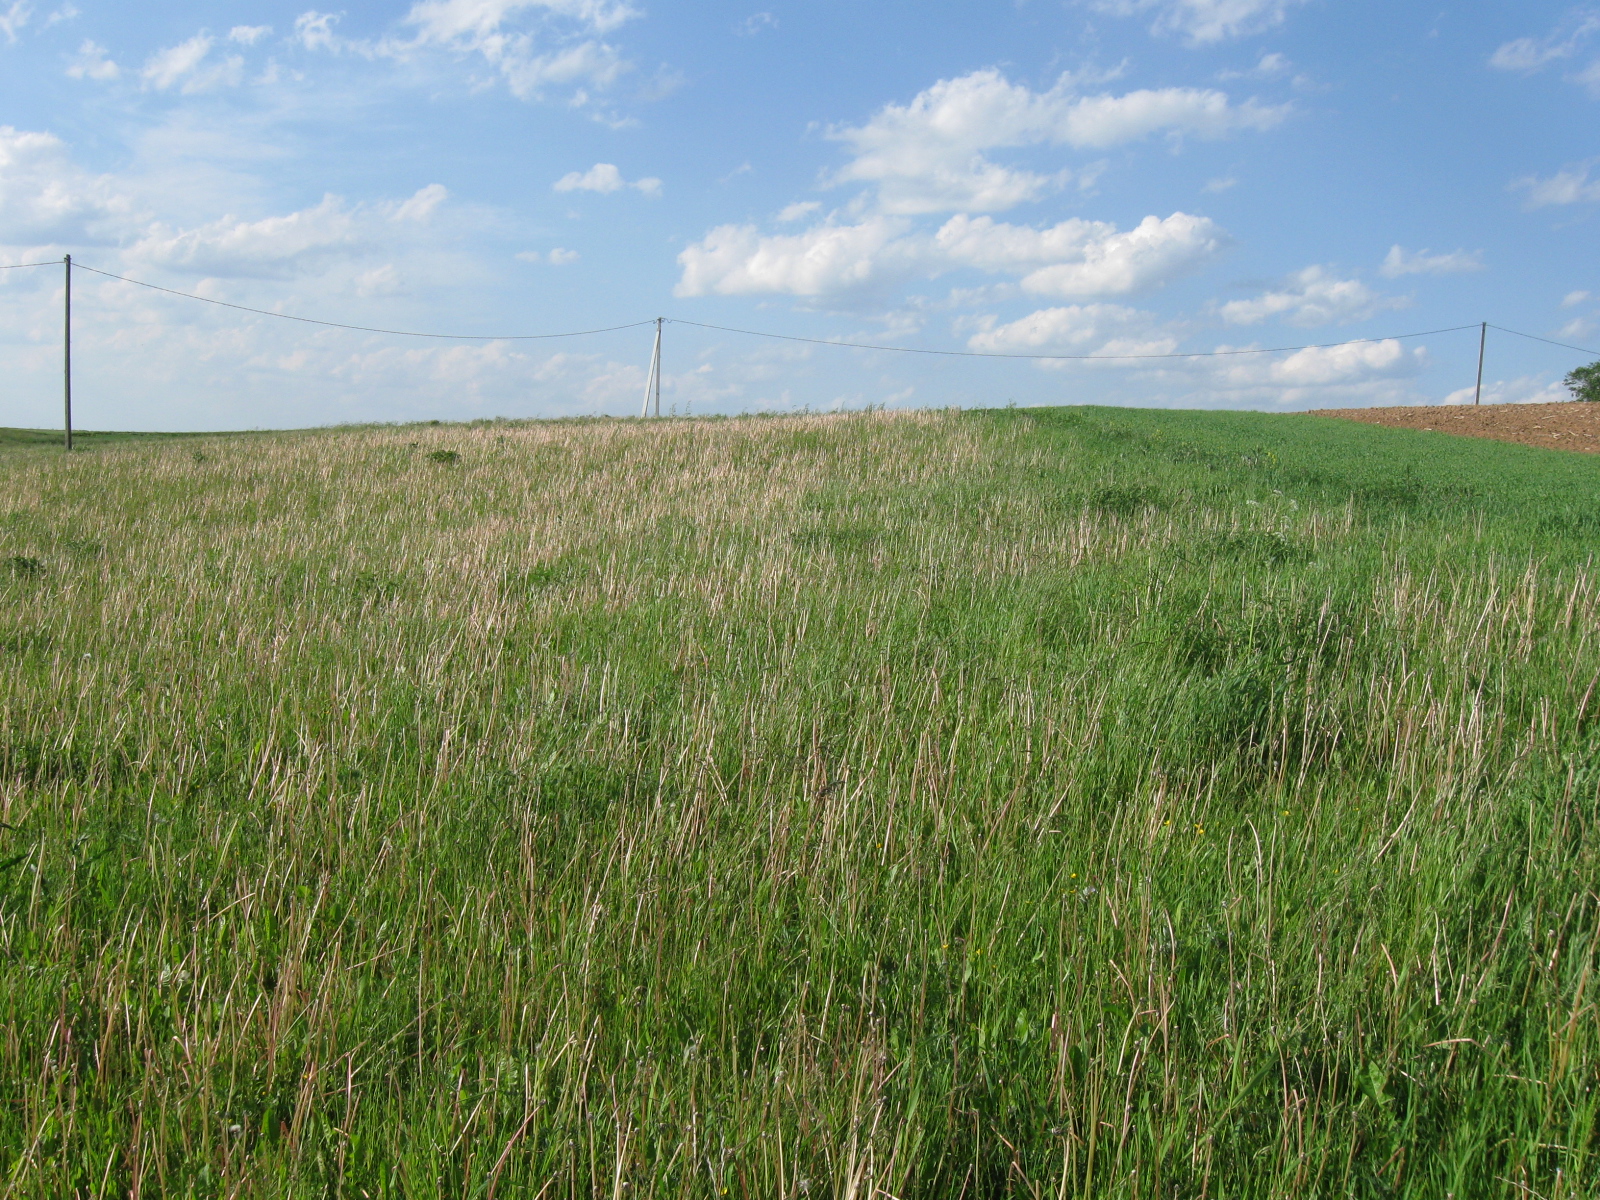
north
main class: Grassland
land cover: Grassland without tree/shrub cover
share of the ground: > 75 %
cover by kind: herbaceous plants 100 %
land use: Agriculture (excluding fallow land and kitchen gardens)
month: June
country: LT
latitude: 54.2398
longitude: 23.7278
